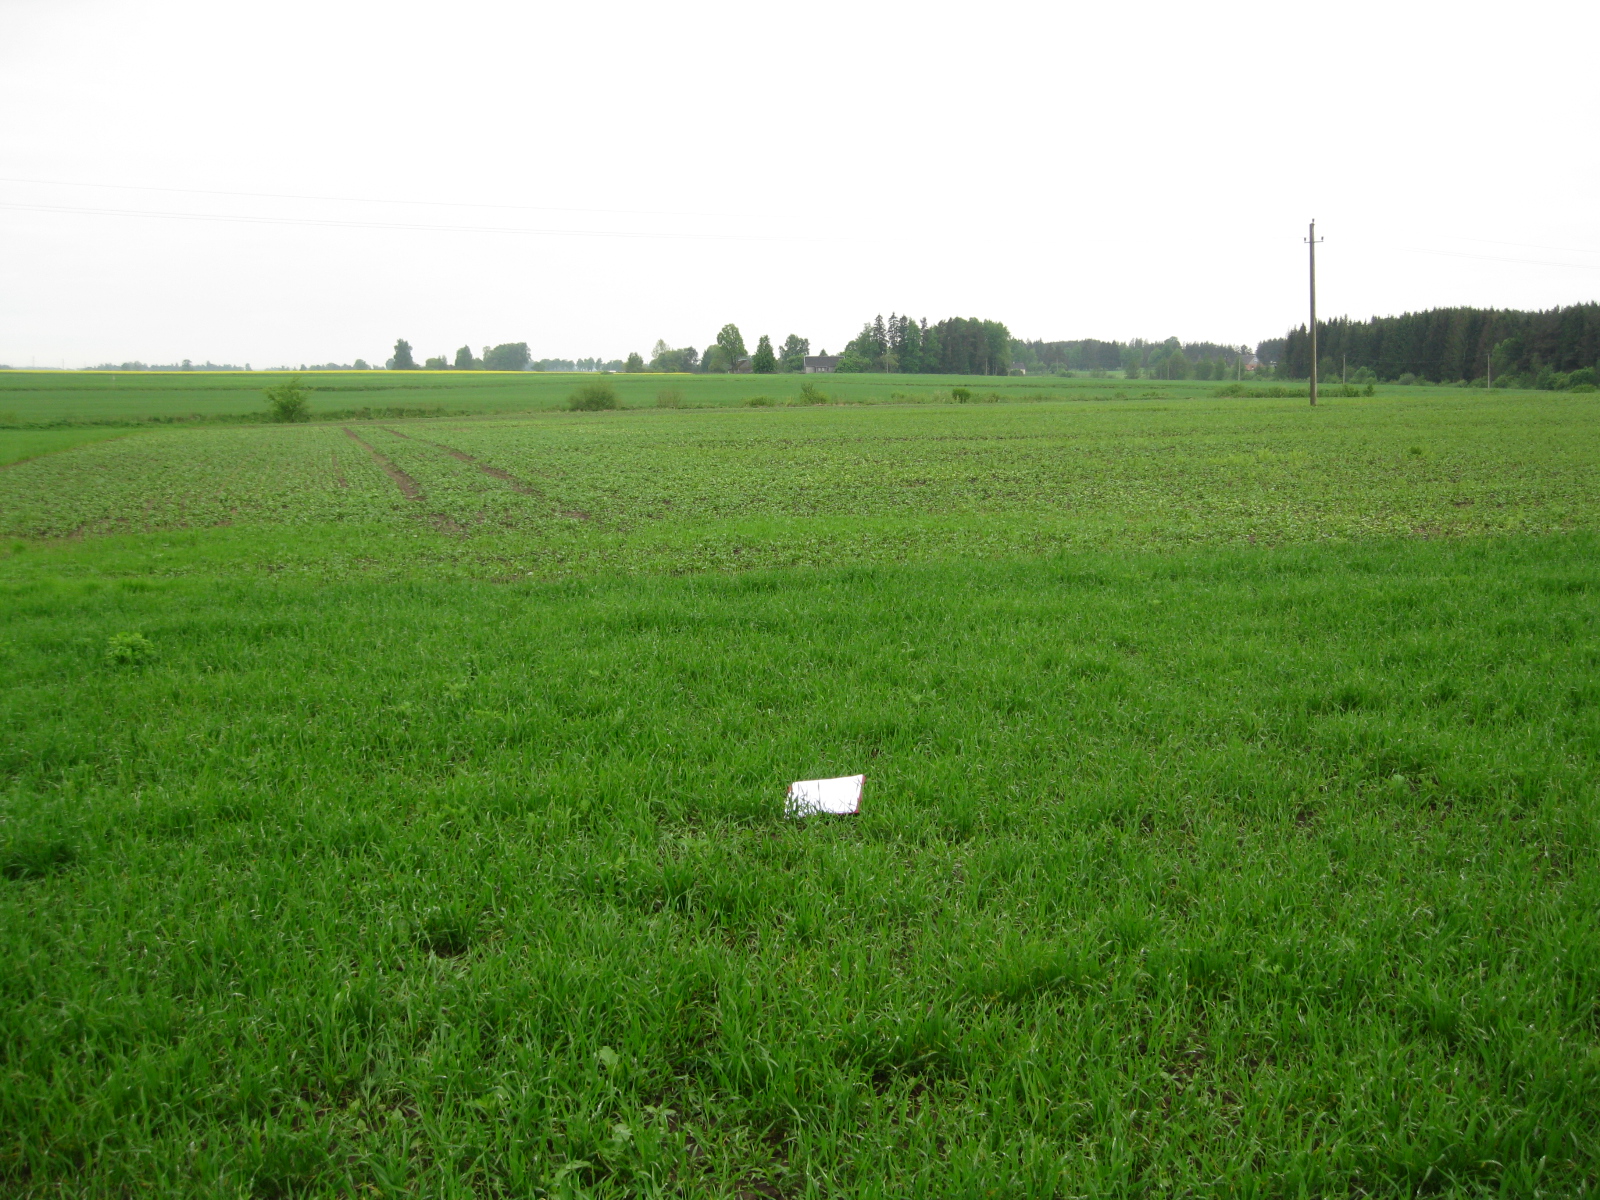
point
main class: Cropland
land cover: Common wheat
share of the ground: > 75 %
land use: Agriculture (excluding fallow land and kitchen gardens)
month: May
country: LT
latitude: 55.9062
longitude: 24.3475
